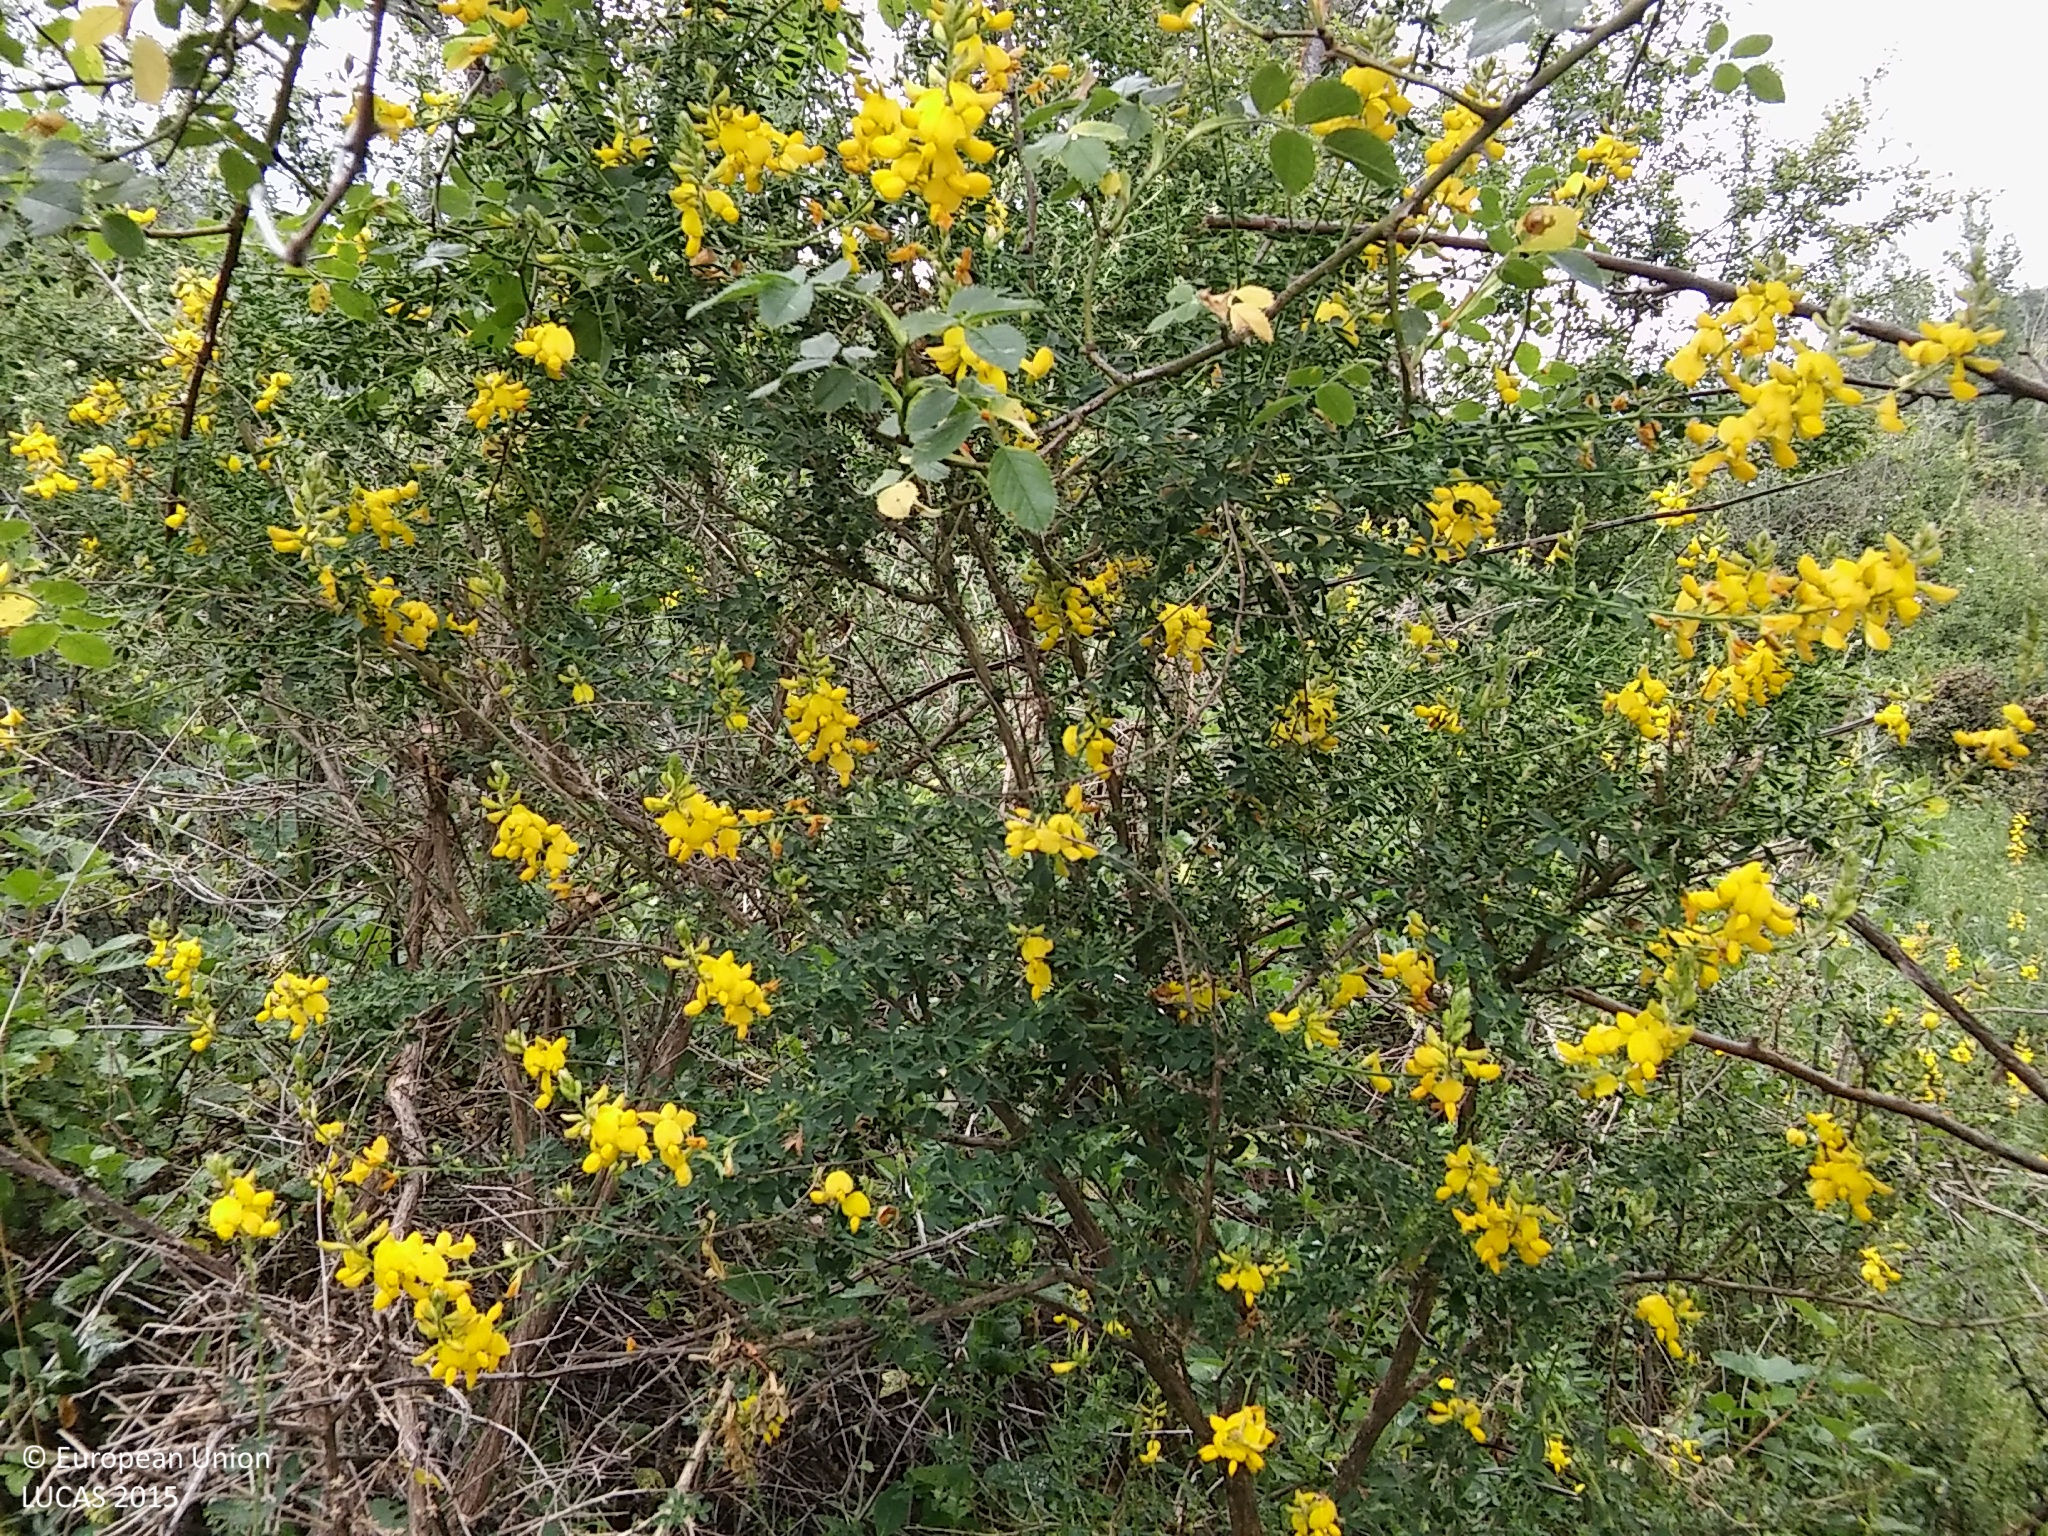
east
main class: Woodland
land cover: Broadleaved woodland
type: floodplain forest
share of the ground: 25 - 50 %
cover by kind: shrubs 60 %, broadleaved forest trees 30 %, herbaceous plants 10 %
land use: Semi-natural and natural areas not in use
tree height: > 5 m
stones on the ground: 25 - 50 %
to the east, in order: Broadleaved woodland; Rivers and streams; Broadleaved woodland; Shrubland with sparse tree cover; Other coniferous woodland; Tracks; Other coniferous woodland
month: June
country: ES
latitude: 41.2250
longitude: -3.5614
